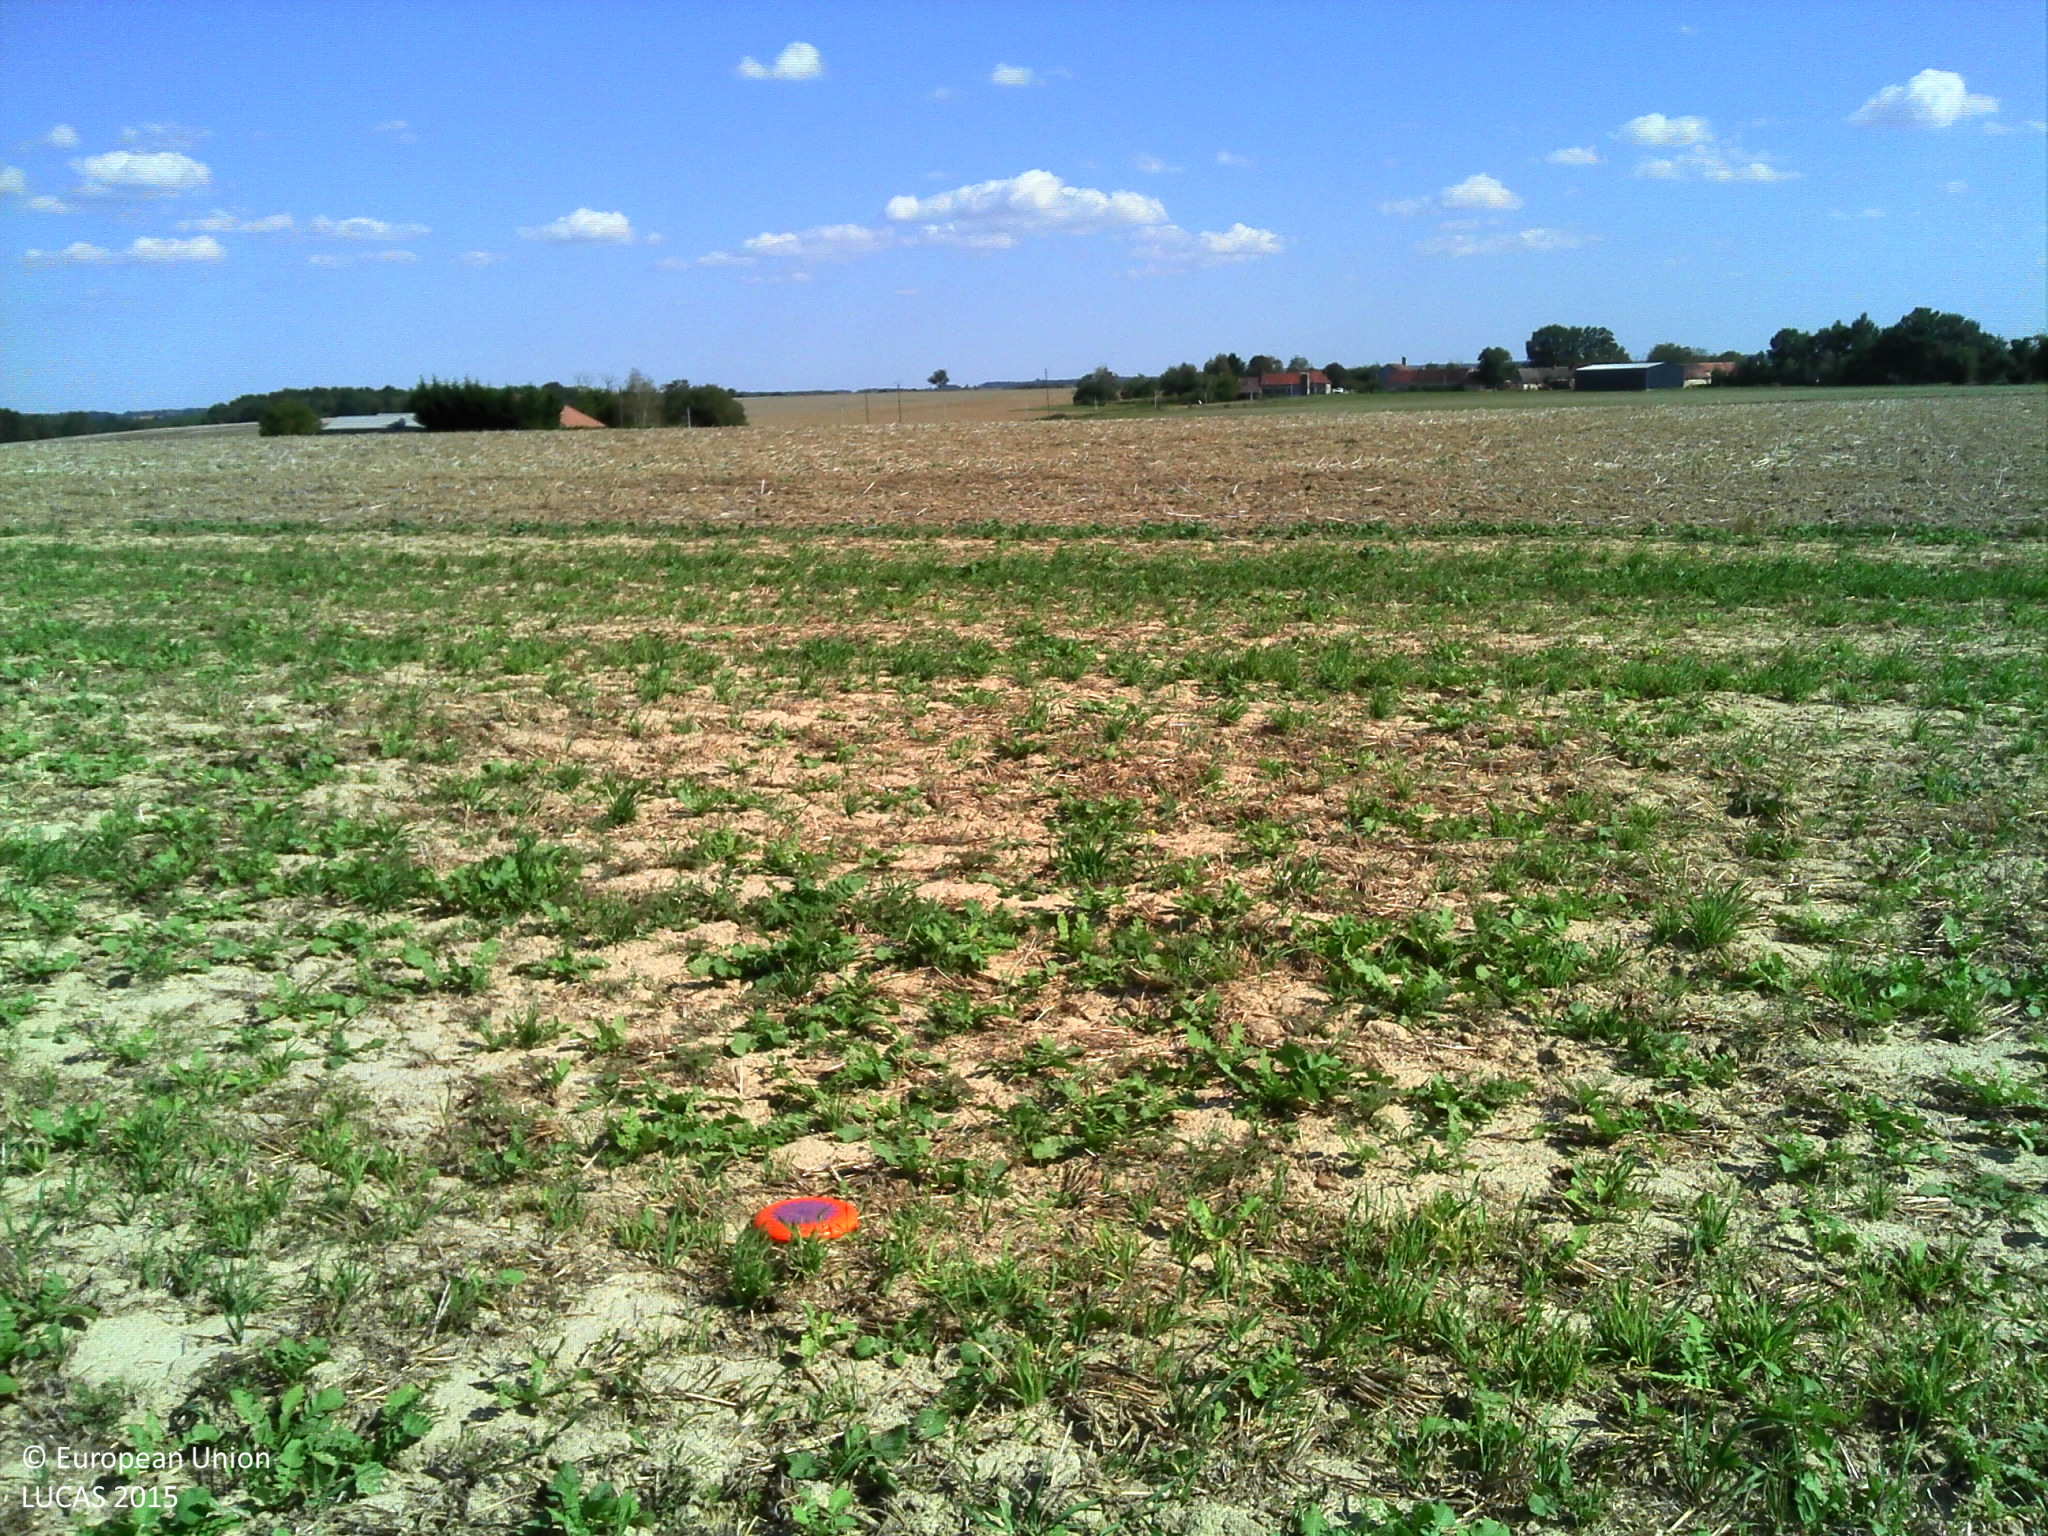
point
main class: Cropland
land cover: Other root crops
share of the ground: < 10 %
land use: Agriculture (excluding fallow land and kitchen gardens)
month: September
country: FR
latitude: 47.1156
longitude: 1.4866
